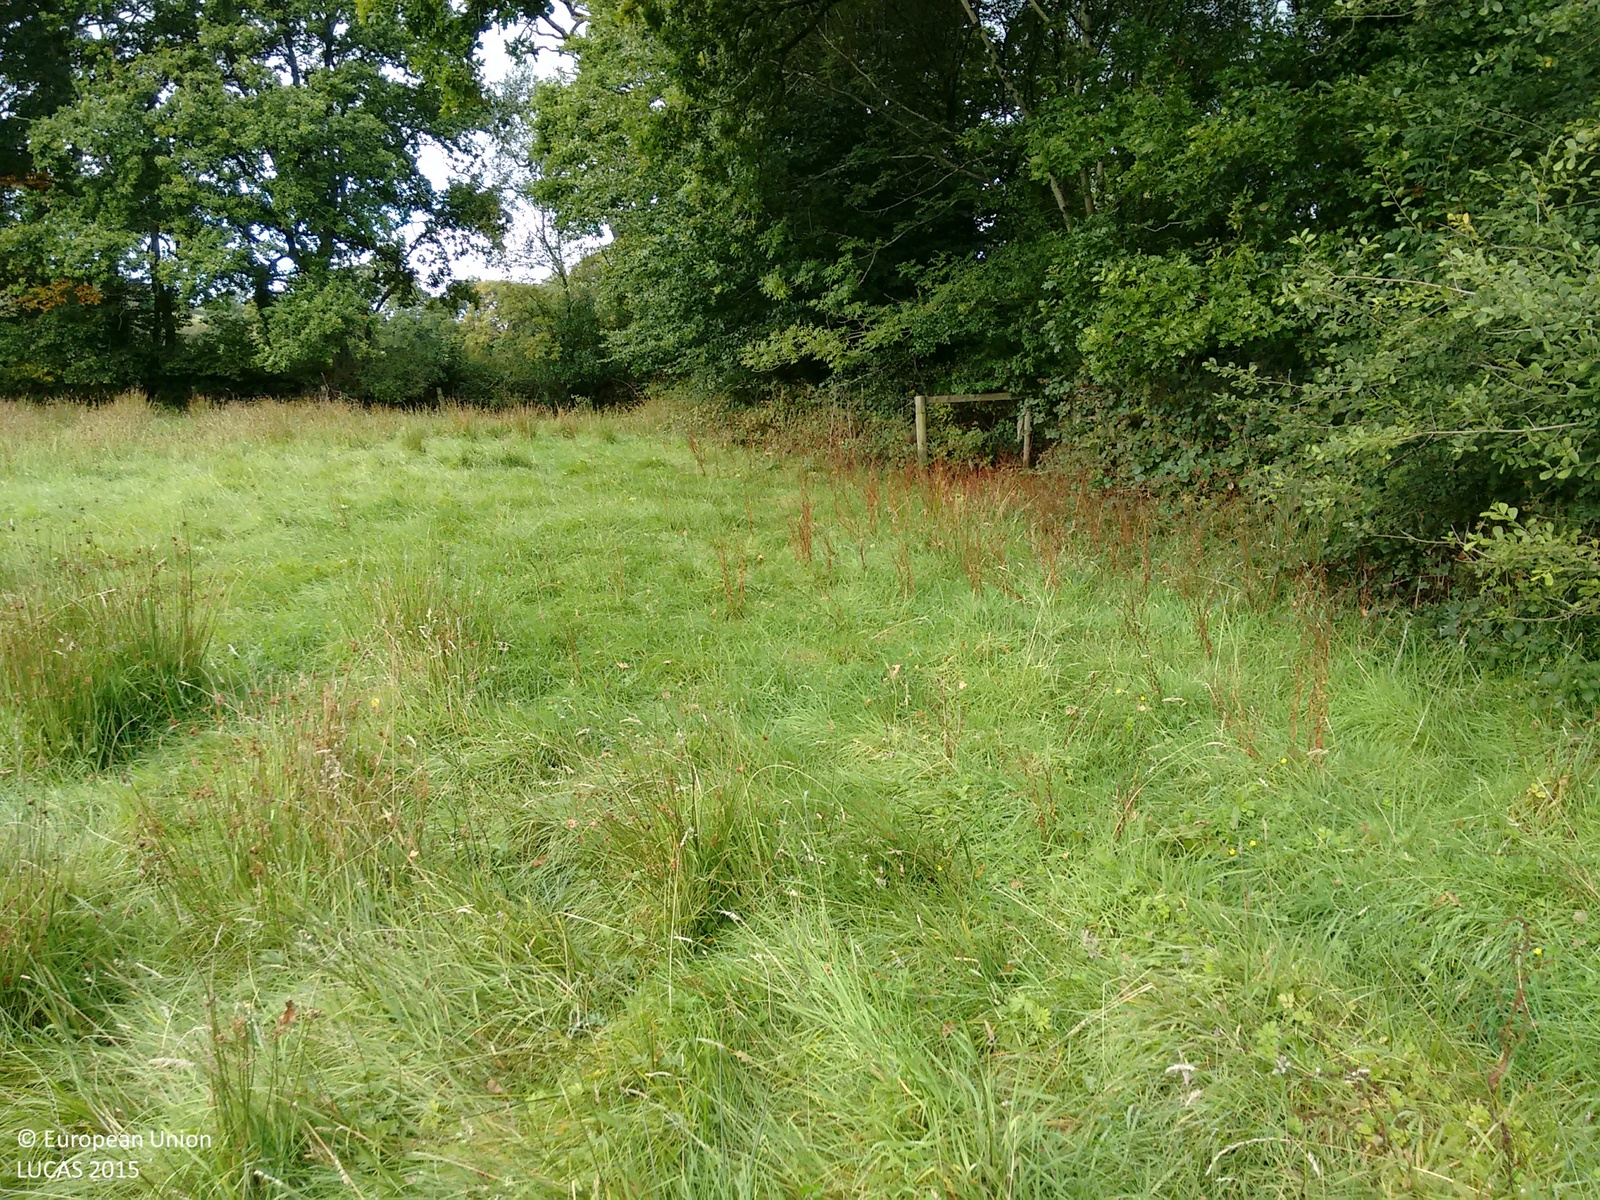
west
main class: Grassland
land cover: Grassland without tree/shrub cover
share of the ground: > 75 %
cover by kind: herbaceous plants 100 %
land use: Agriculture (excluding fallow land and kitchen gardens)
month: September
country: GB
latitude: 50.8314
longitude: -4.1390
